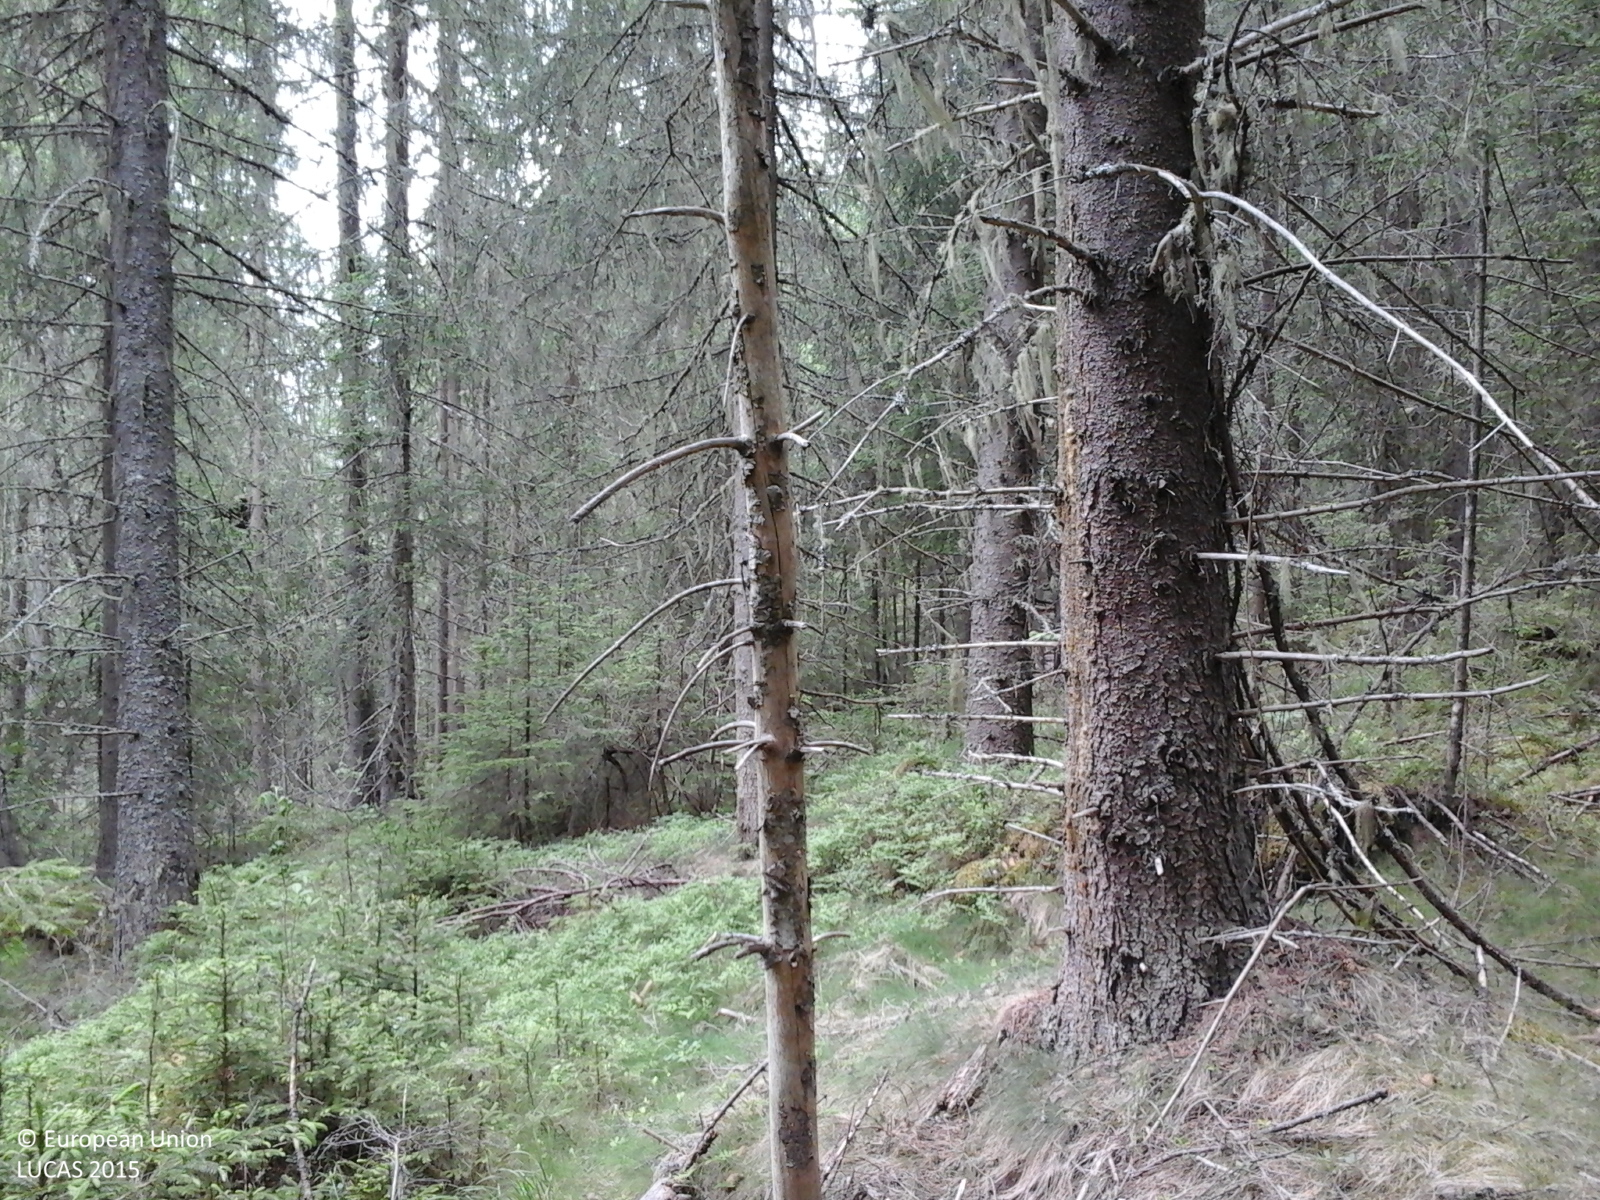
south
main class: Woodland
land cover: Spruce dominated coniferous woodland
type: alpine coniferous forest
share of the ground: > 75 %
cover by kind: coniferous forest trees 100 %
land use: Forestry
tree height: > 5 m
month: June
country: RO
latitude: 47.1480
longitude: 25.4225
